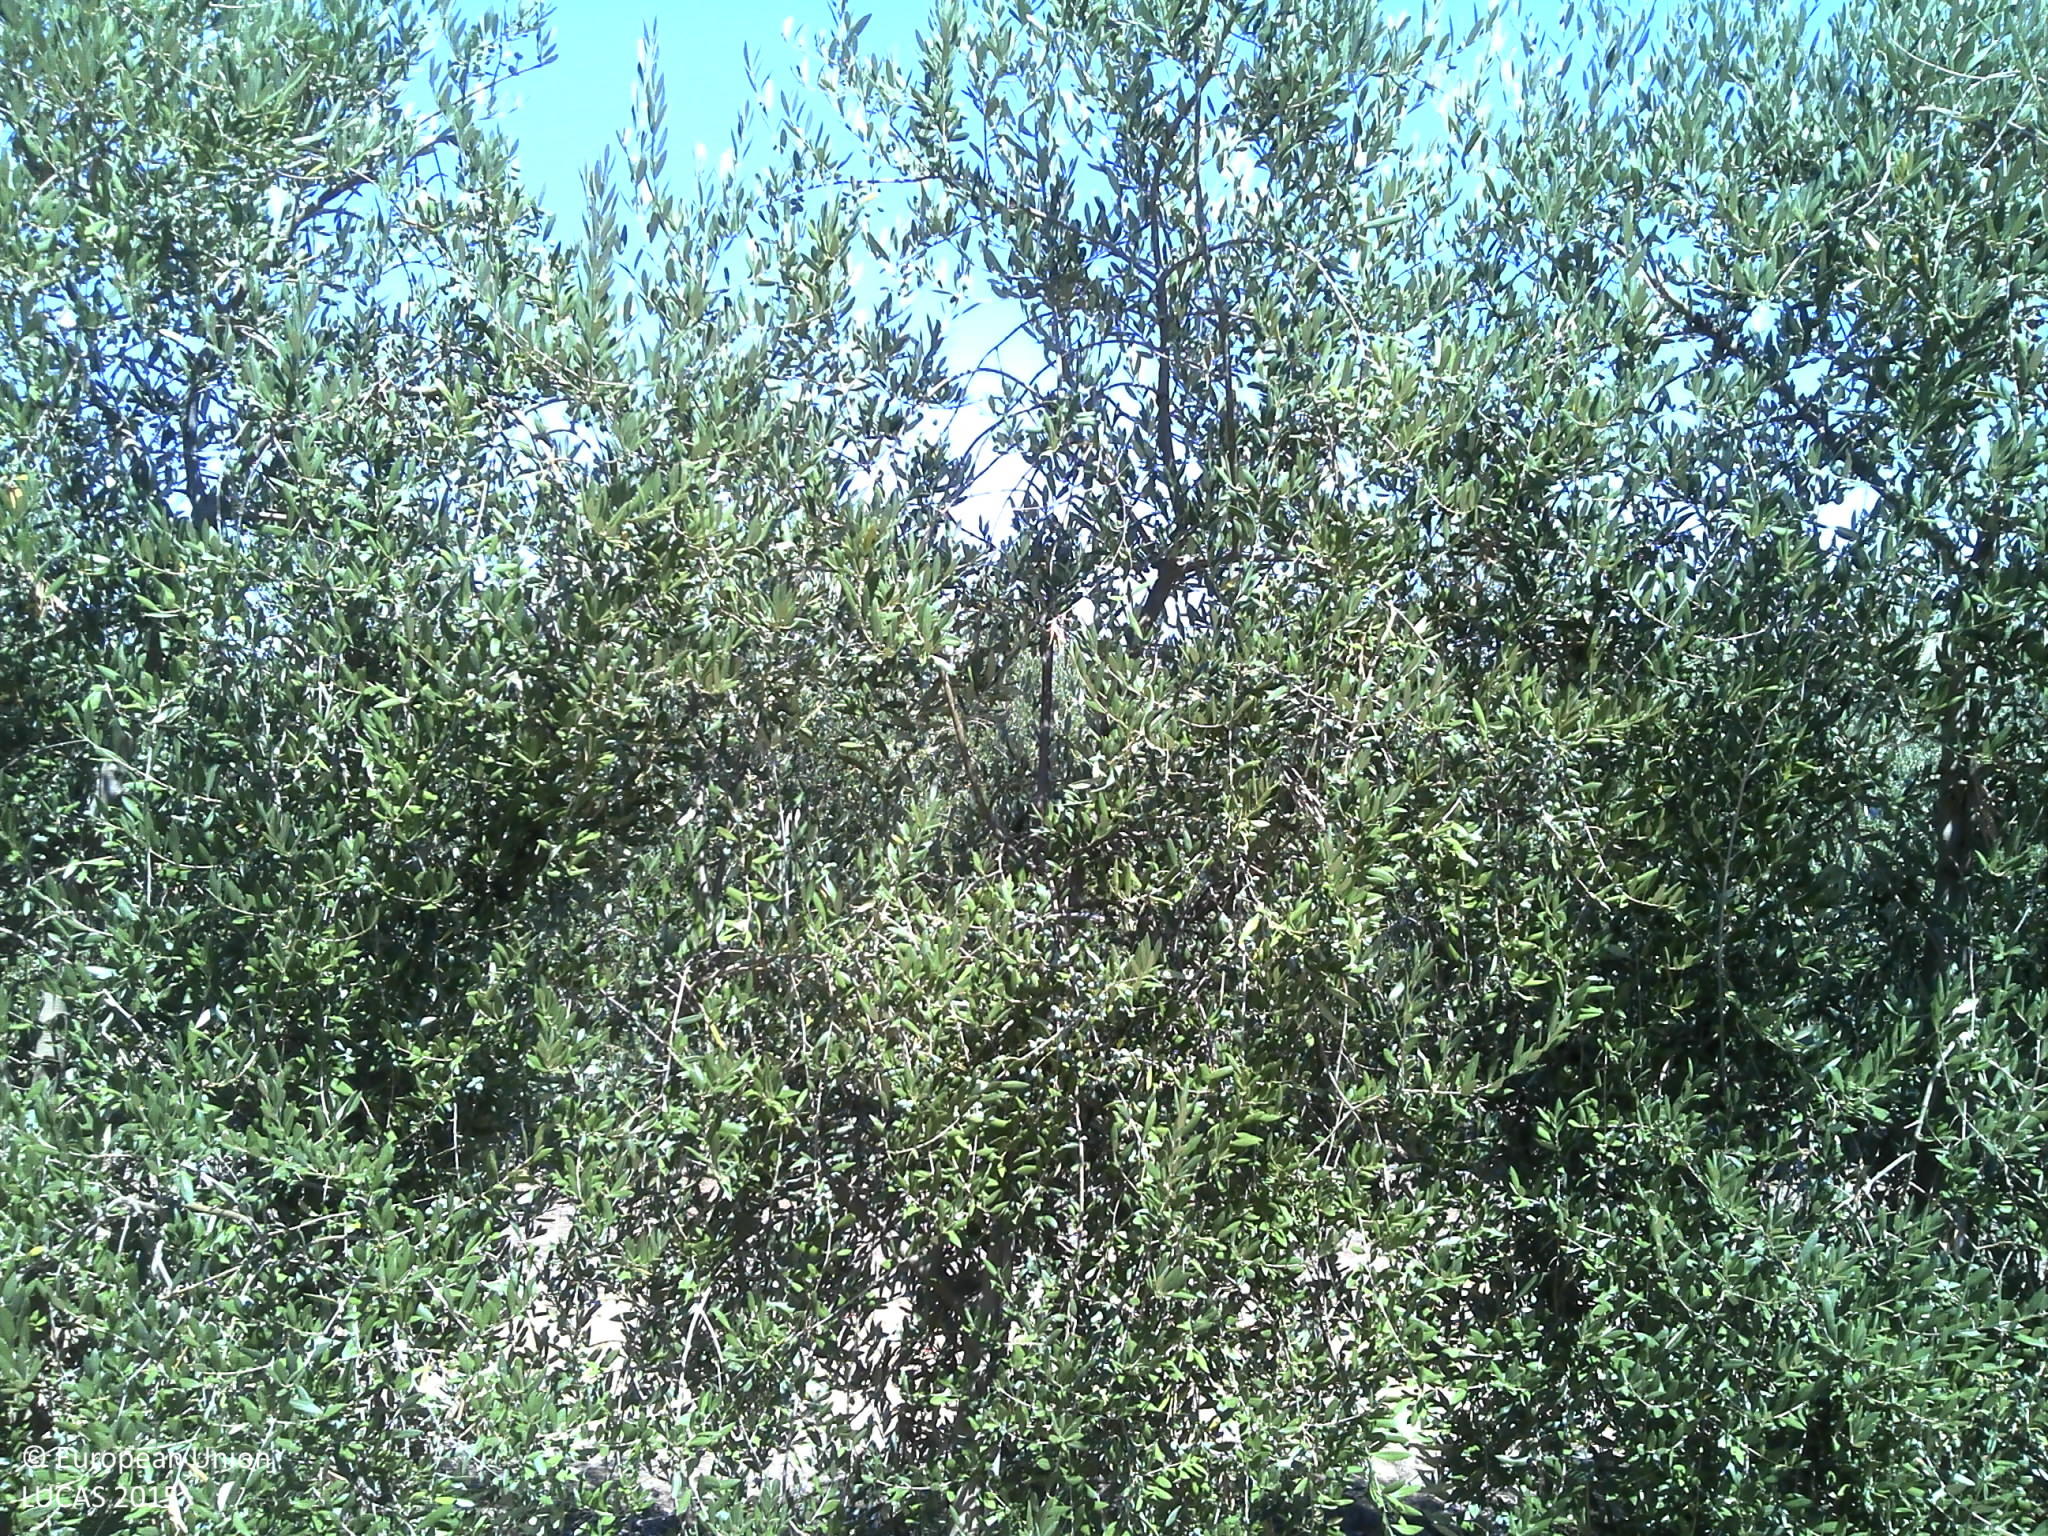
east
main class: Cropland
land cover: Olive groves
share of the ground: 25 - 50 %
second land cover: Grassland without tree/shrub cover
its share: 25 - 50 %
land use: Agriculture (excluding fallow land and kitchen gardens)
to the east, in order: Olive groves; Grassland without tree/shrub cover; Olive groves; Tracks; Olive groves
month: July
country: PT
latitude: 39.0026
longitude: -7.5561
